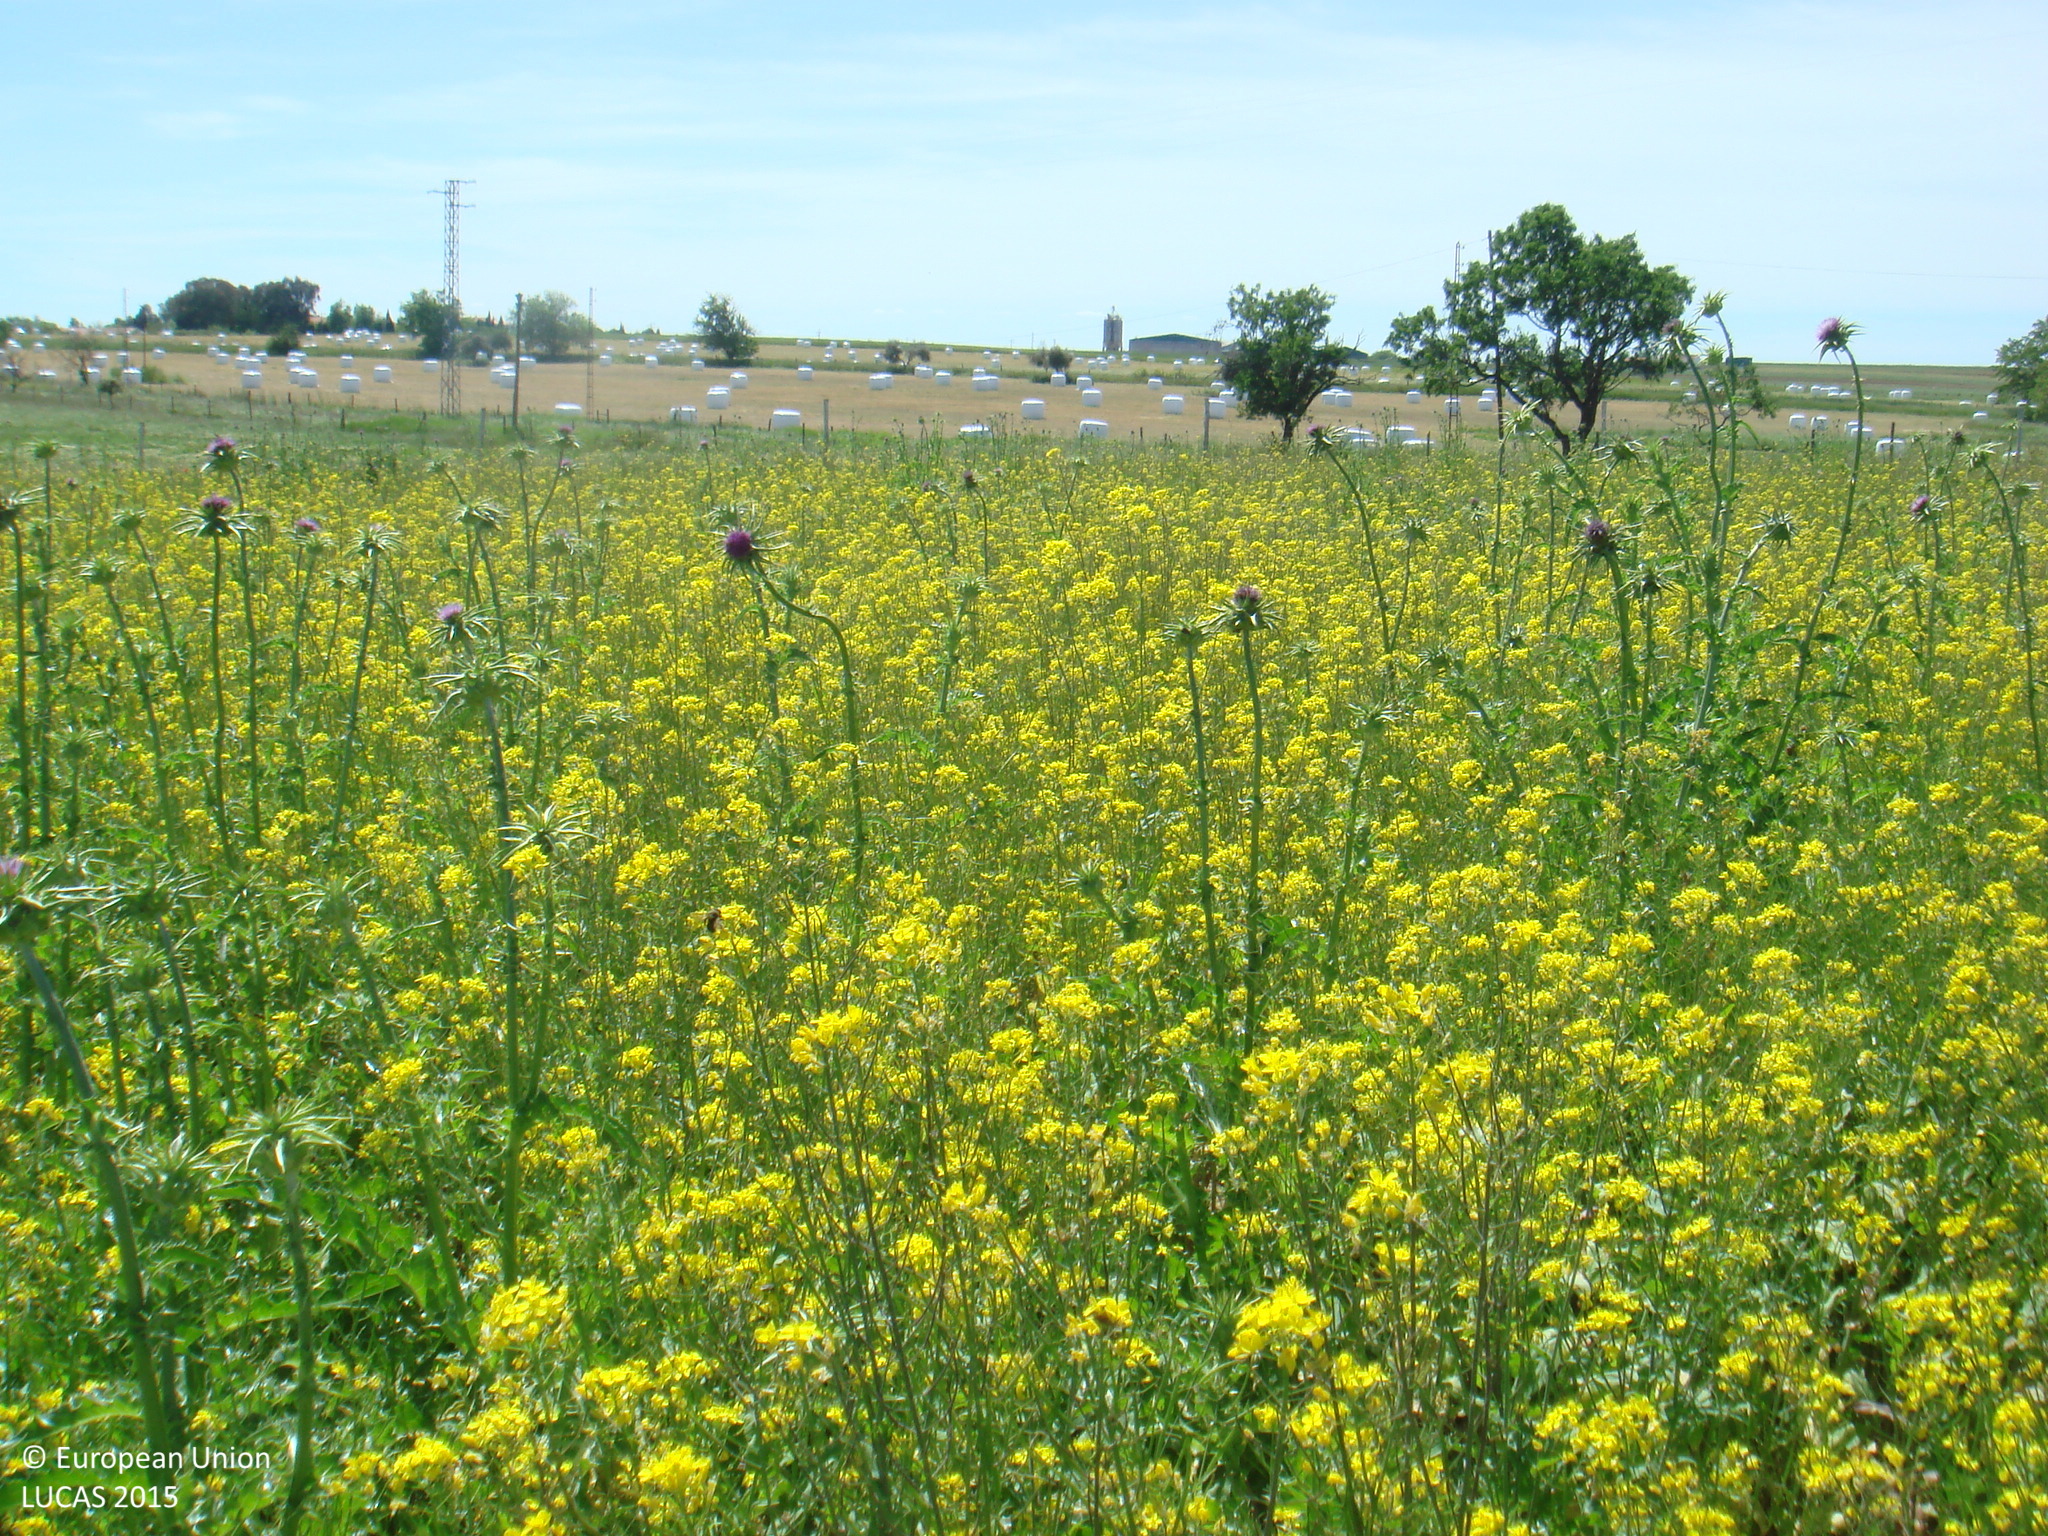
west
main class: Grassland
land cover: Spontaneously vegetated surfaces
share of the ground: > 75 %
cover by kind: herbaceous plants 95 %, shrubs 5 %
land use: Fallow land
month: April
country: ES
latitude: 38.5017
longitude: -5.1079
